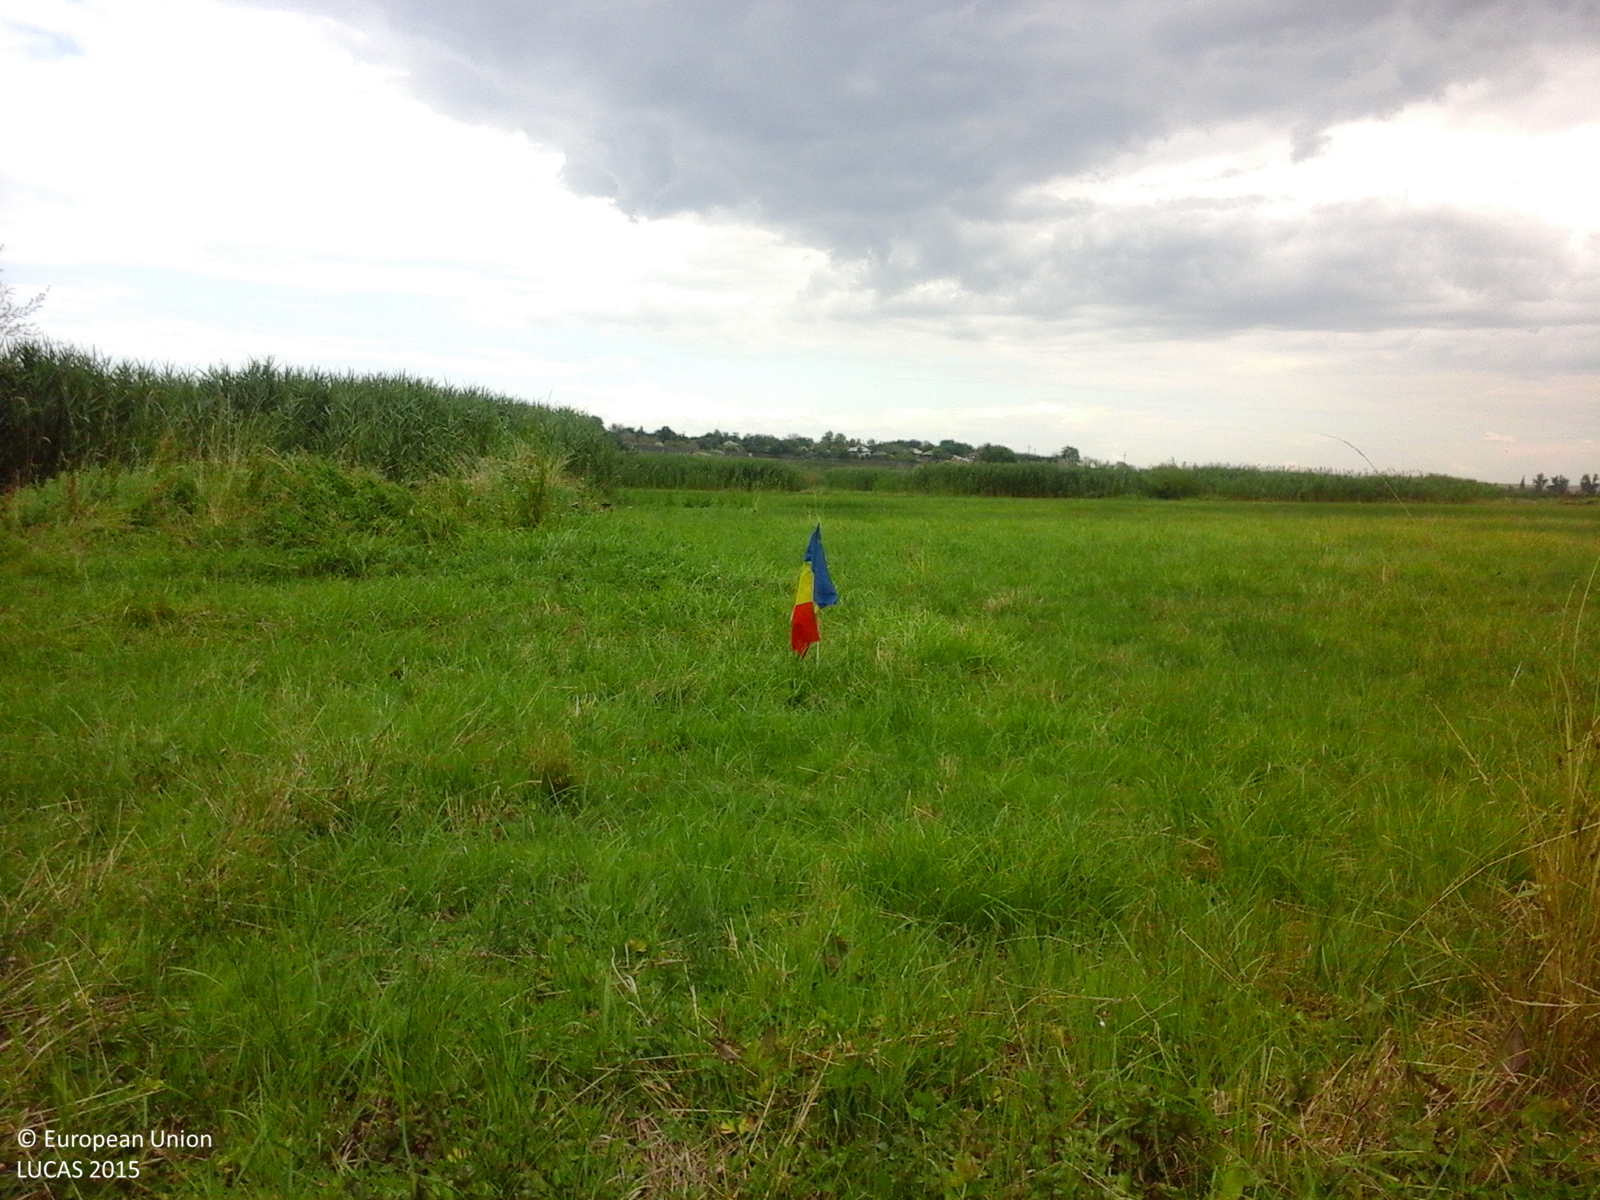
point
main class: Grassland
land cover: Grassland without tree/shrub cover
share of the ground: > 75 %
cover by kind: herbaceous plants 100 %
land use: Agriculture (excluding fallow land and kitchen gardens)
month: July
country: RO
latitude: 44.0143
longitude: 24.8041
